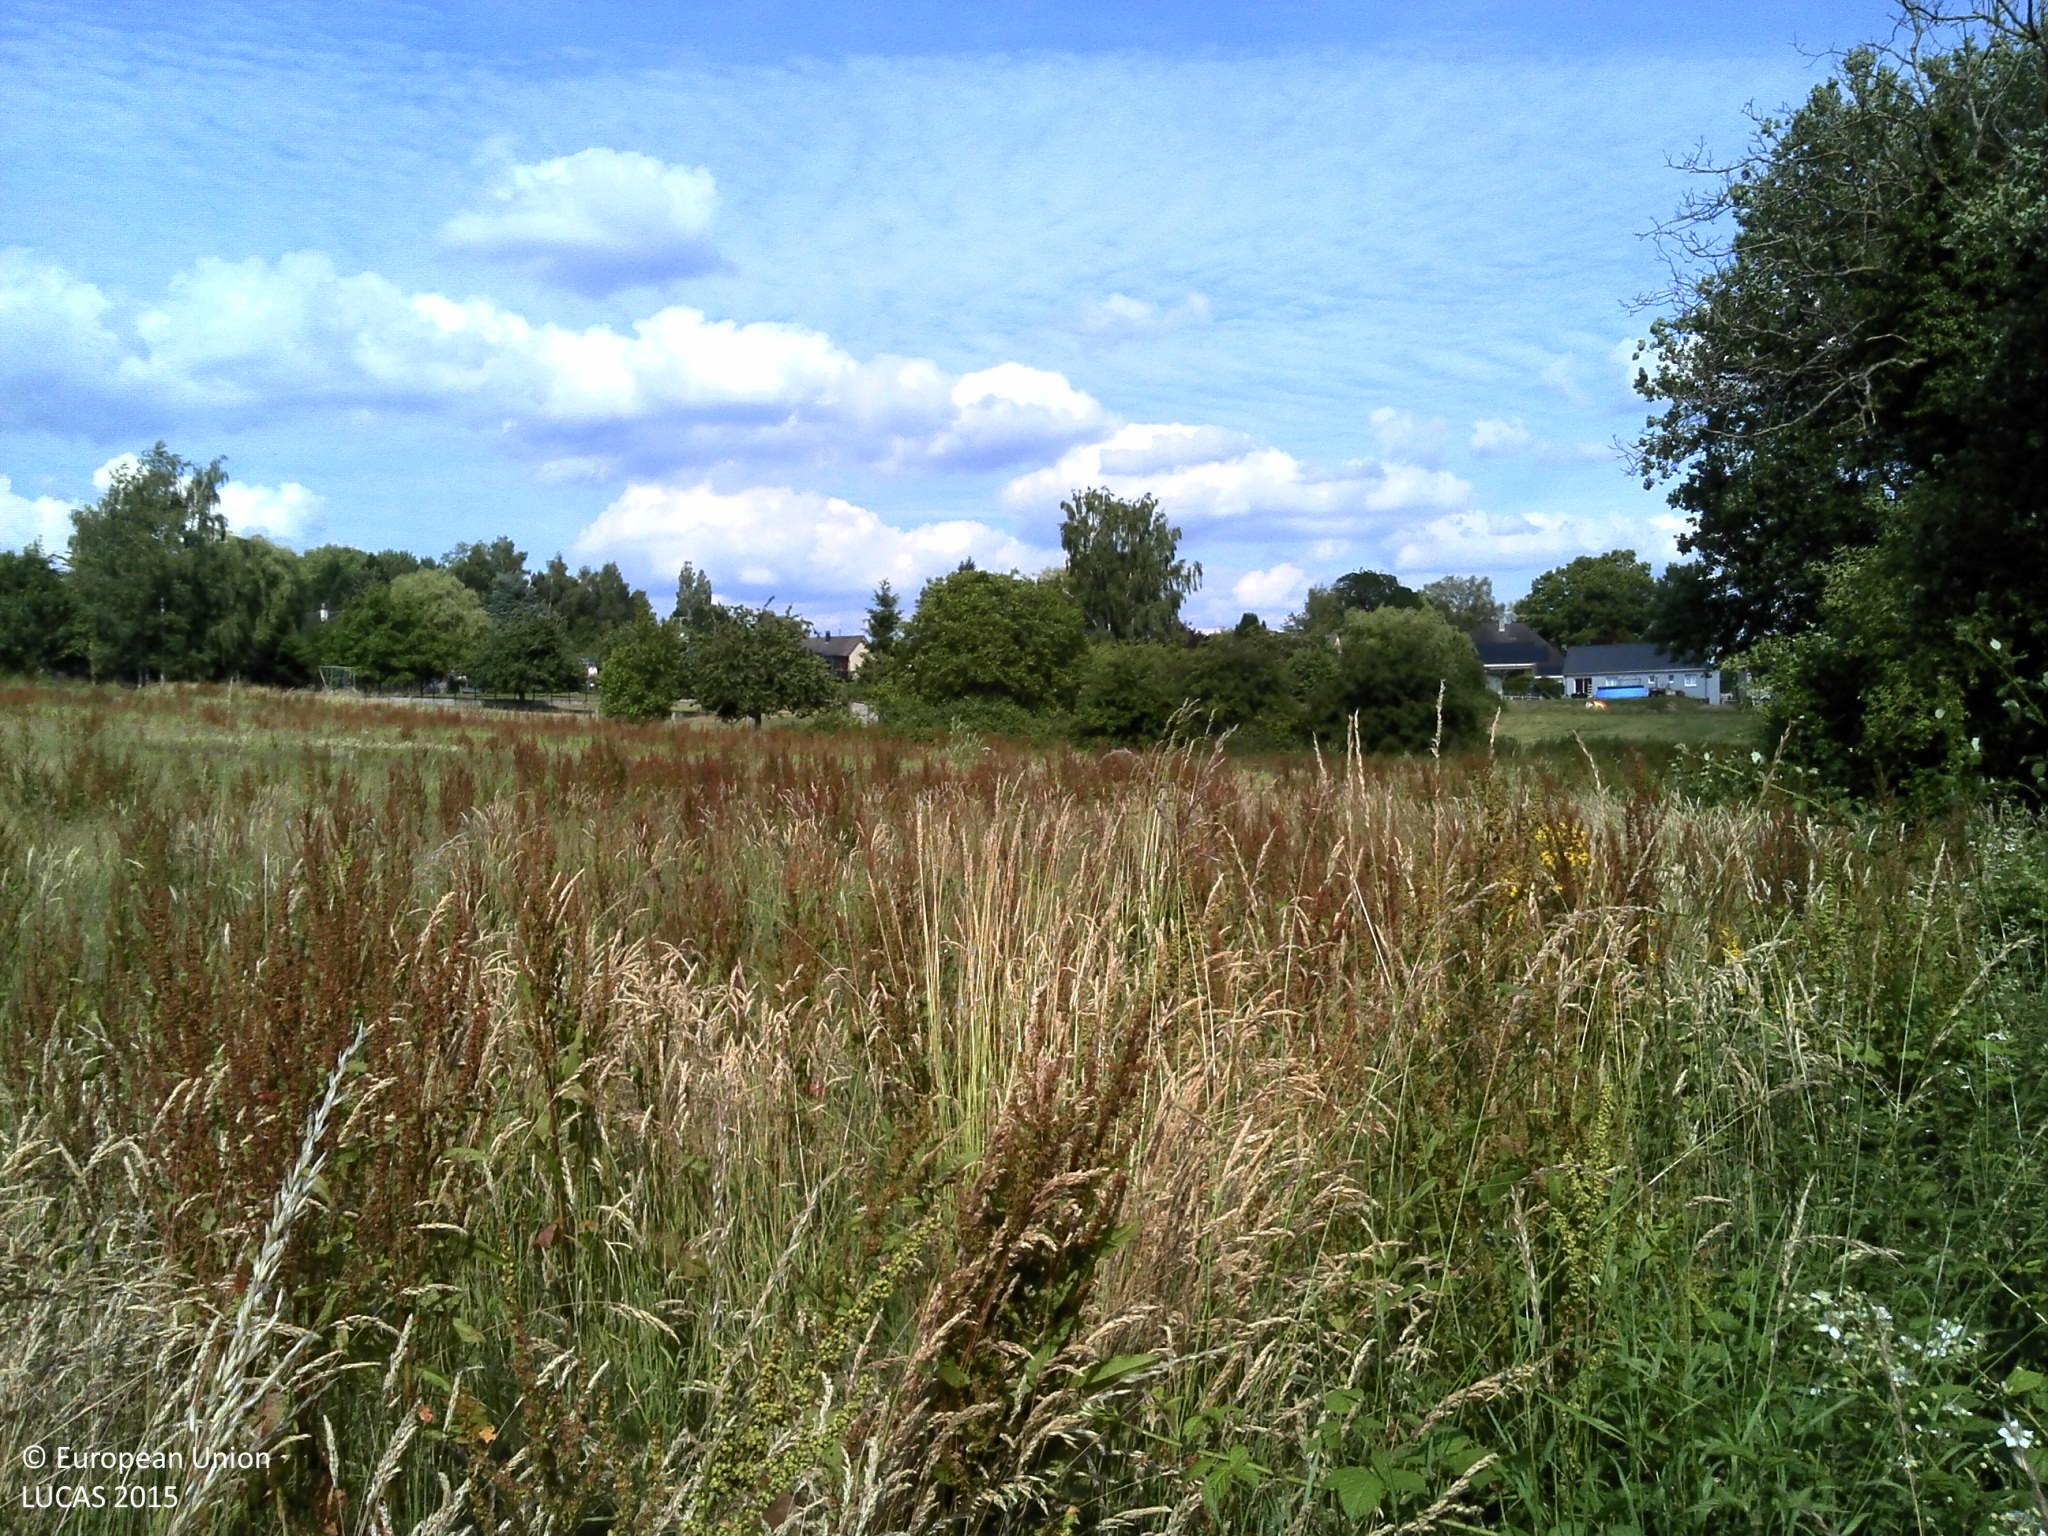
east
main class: Grassland
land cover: Grassland without tree/shrub cover
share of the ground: > 75 %
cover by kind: herbaceous plants 100 %
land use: Residential
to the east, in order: Grassland without tree/shrub cover; Fences; Grassland without tree/shrub cover; Abandoned hedges; Grassland without tree/shrub cover; Artificial constructions in urban areas
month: June
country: FR
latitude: 49.7422
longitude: 4.8209
